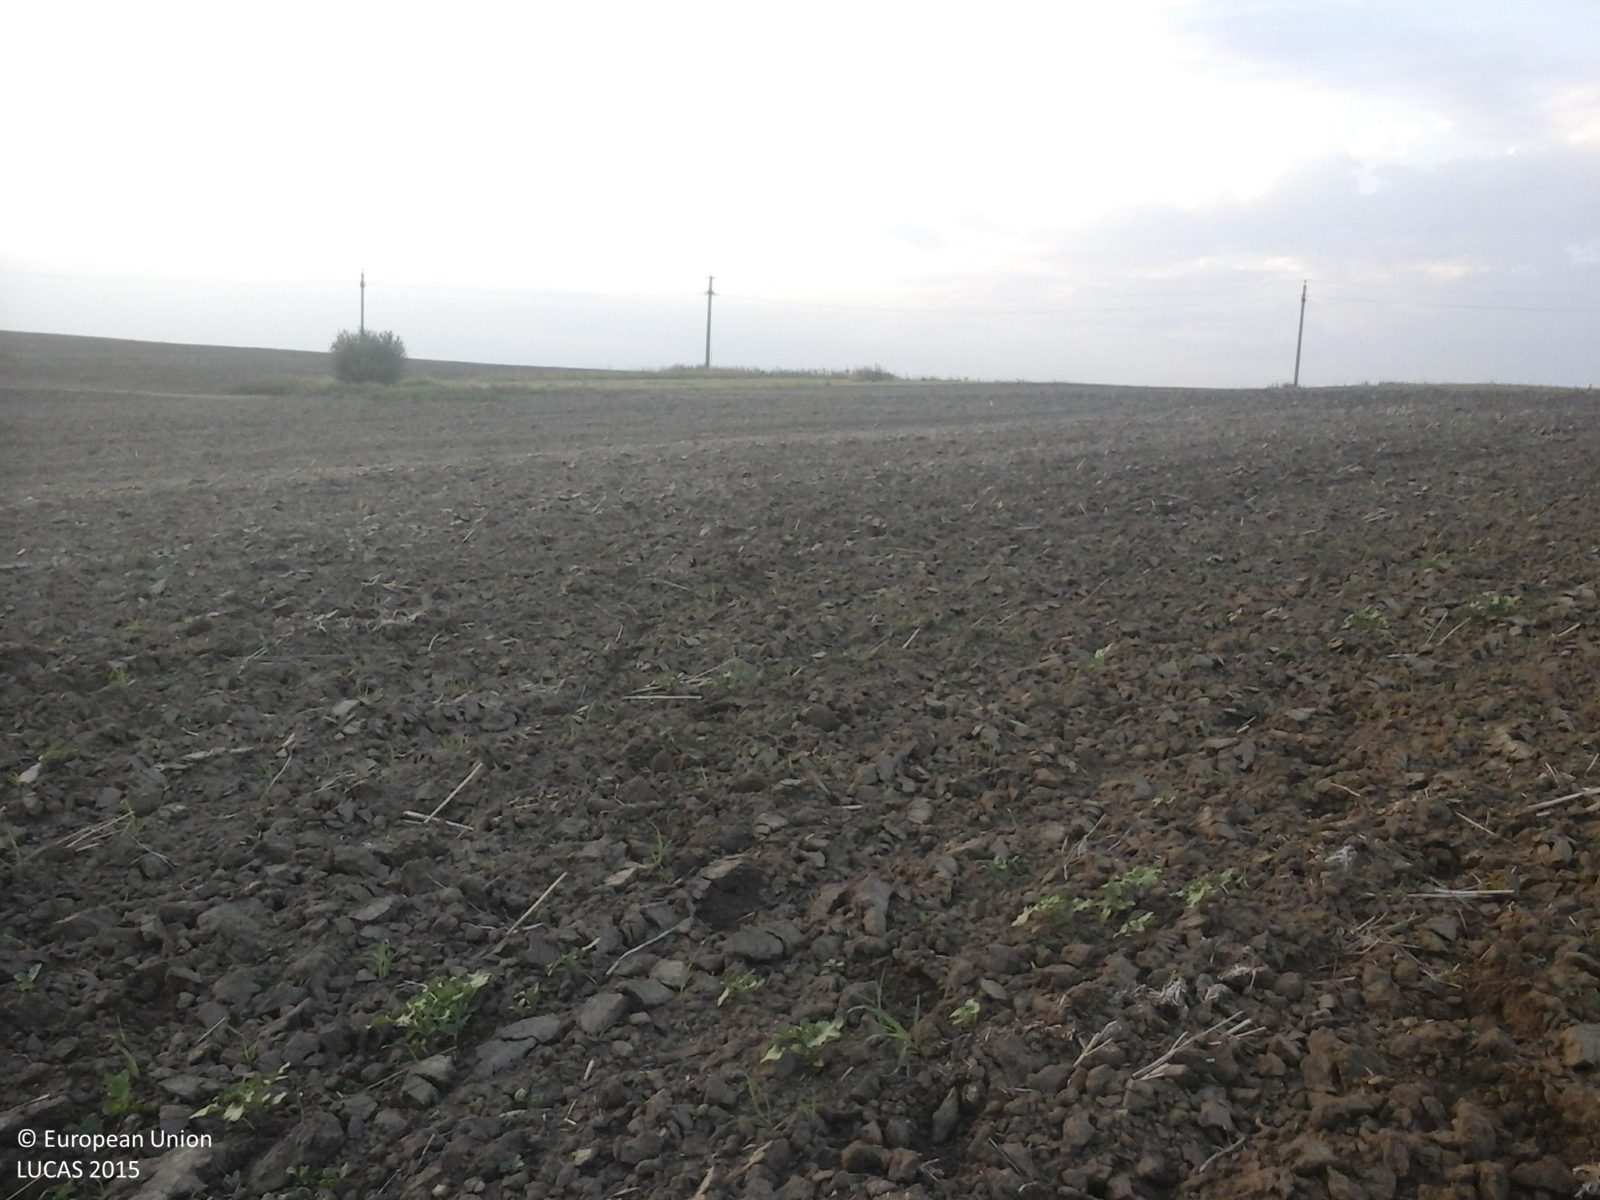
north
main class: Cropland
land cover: Rape and turnip rape
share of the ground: < 10 %
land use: Agriculture (excluding fallow land and kitchen gardens)
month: August
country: RO
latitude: 44.2411
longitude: 28.0757
